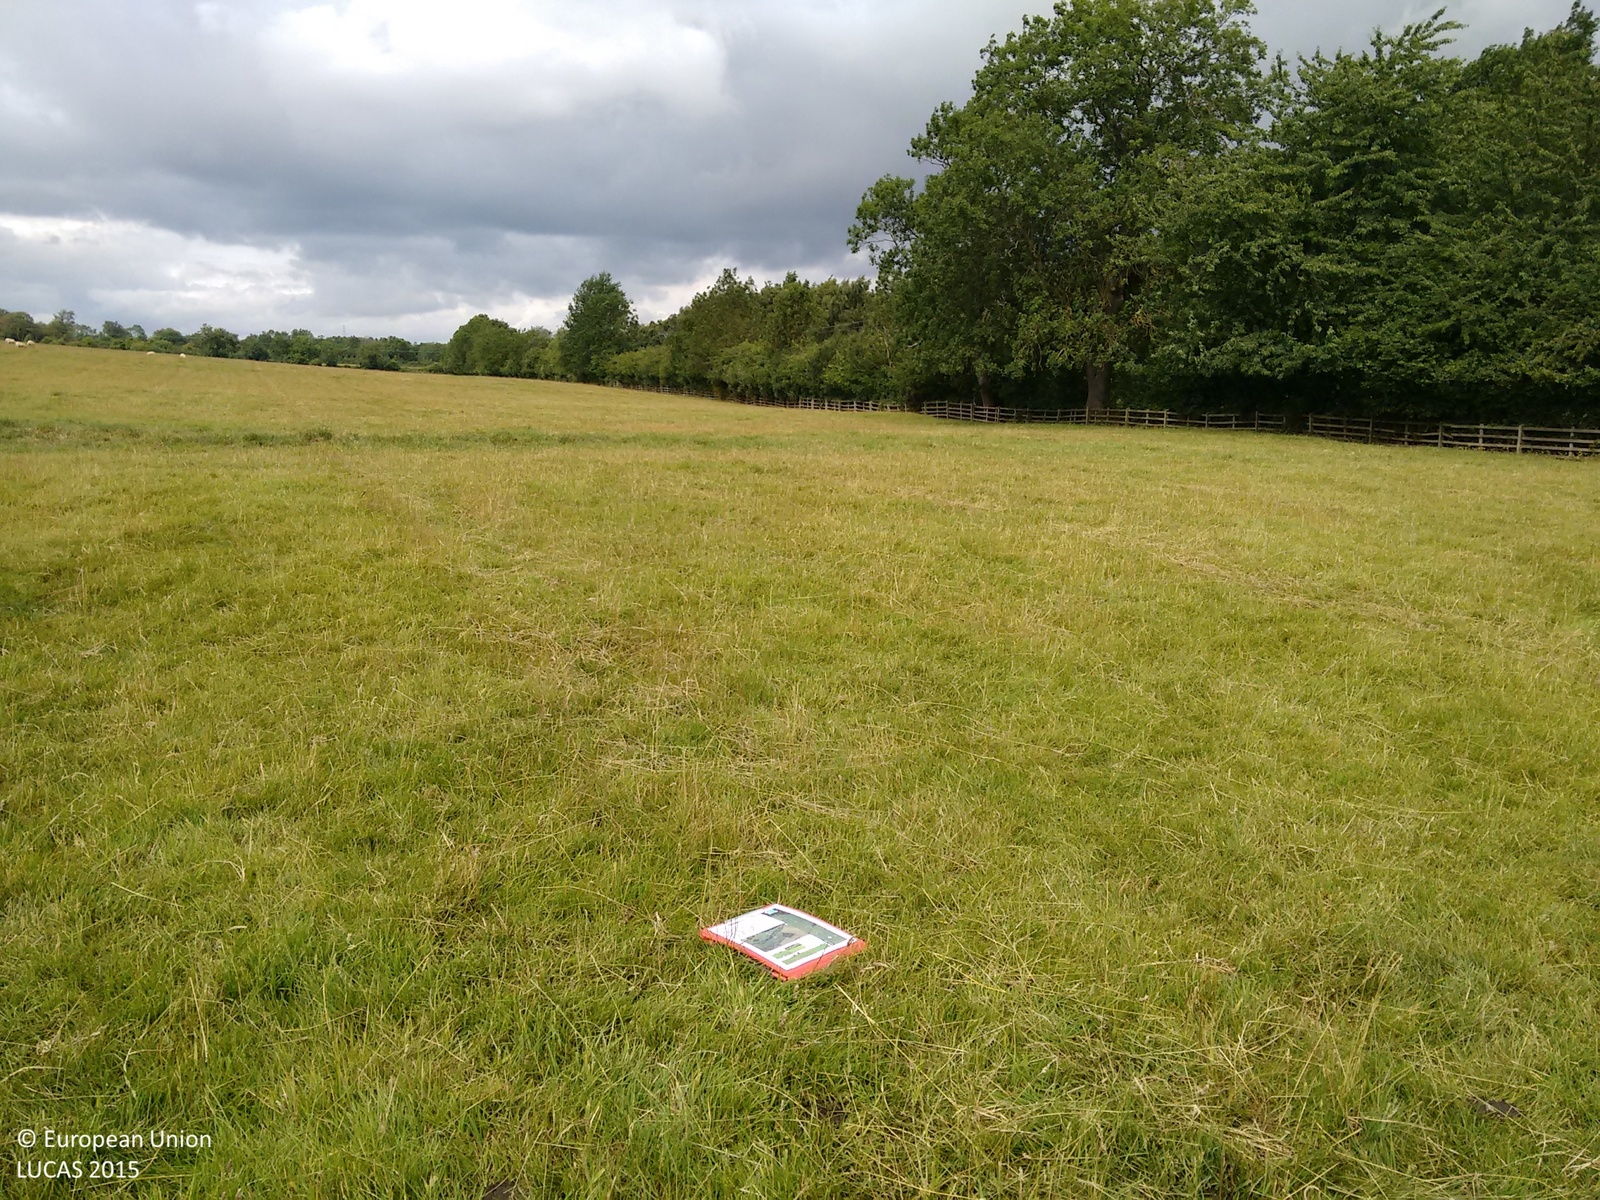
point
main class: Grassland
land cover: Grassland without tree/shrub cover
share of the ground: > 75 %
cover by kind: herbaceous plants 100 %
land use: Agriculture (excluding fallow land and kitchen gardens)
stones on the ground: < 10 %
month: July
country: GB
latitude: 52.6367
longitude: -0.6943
